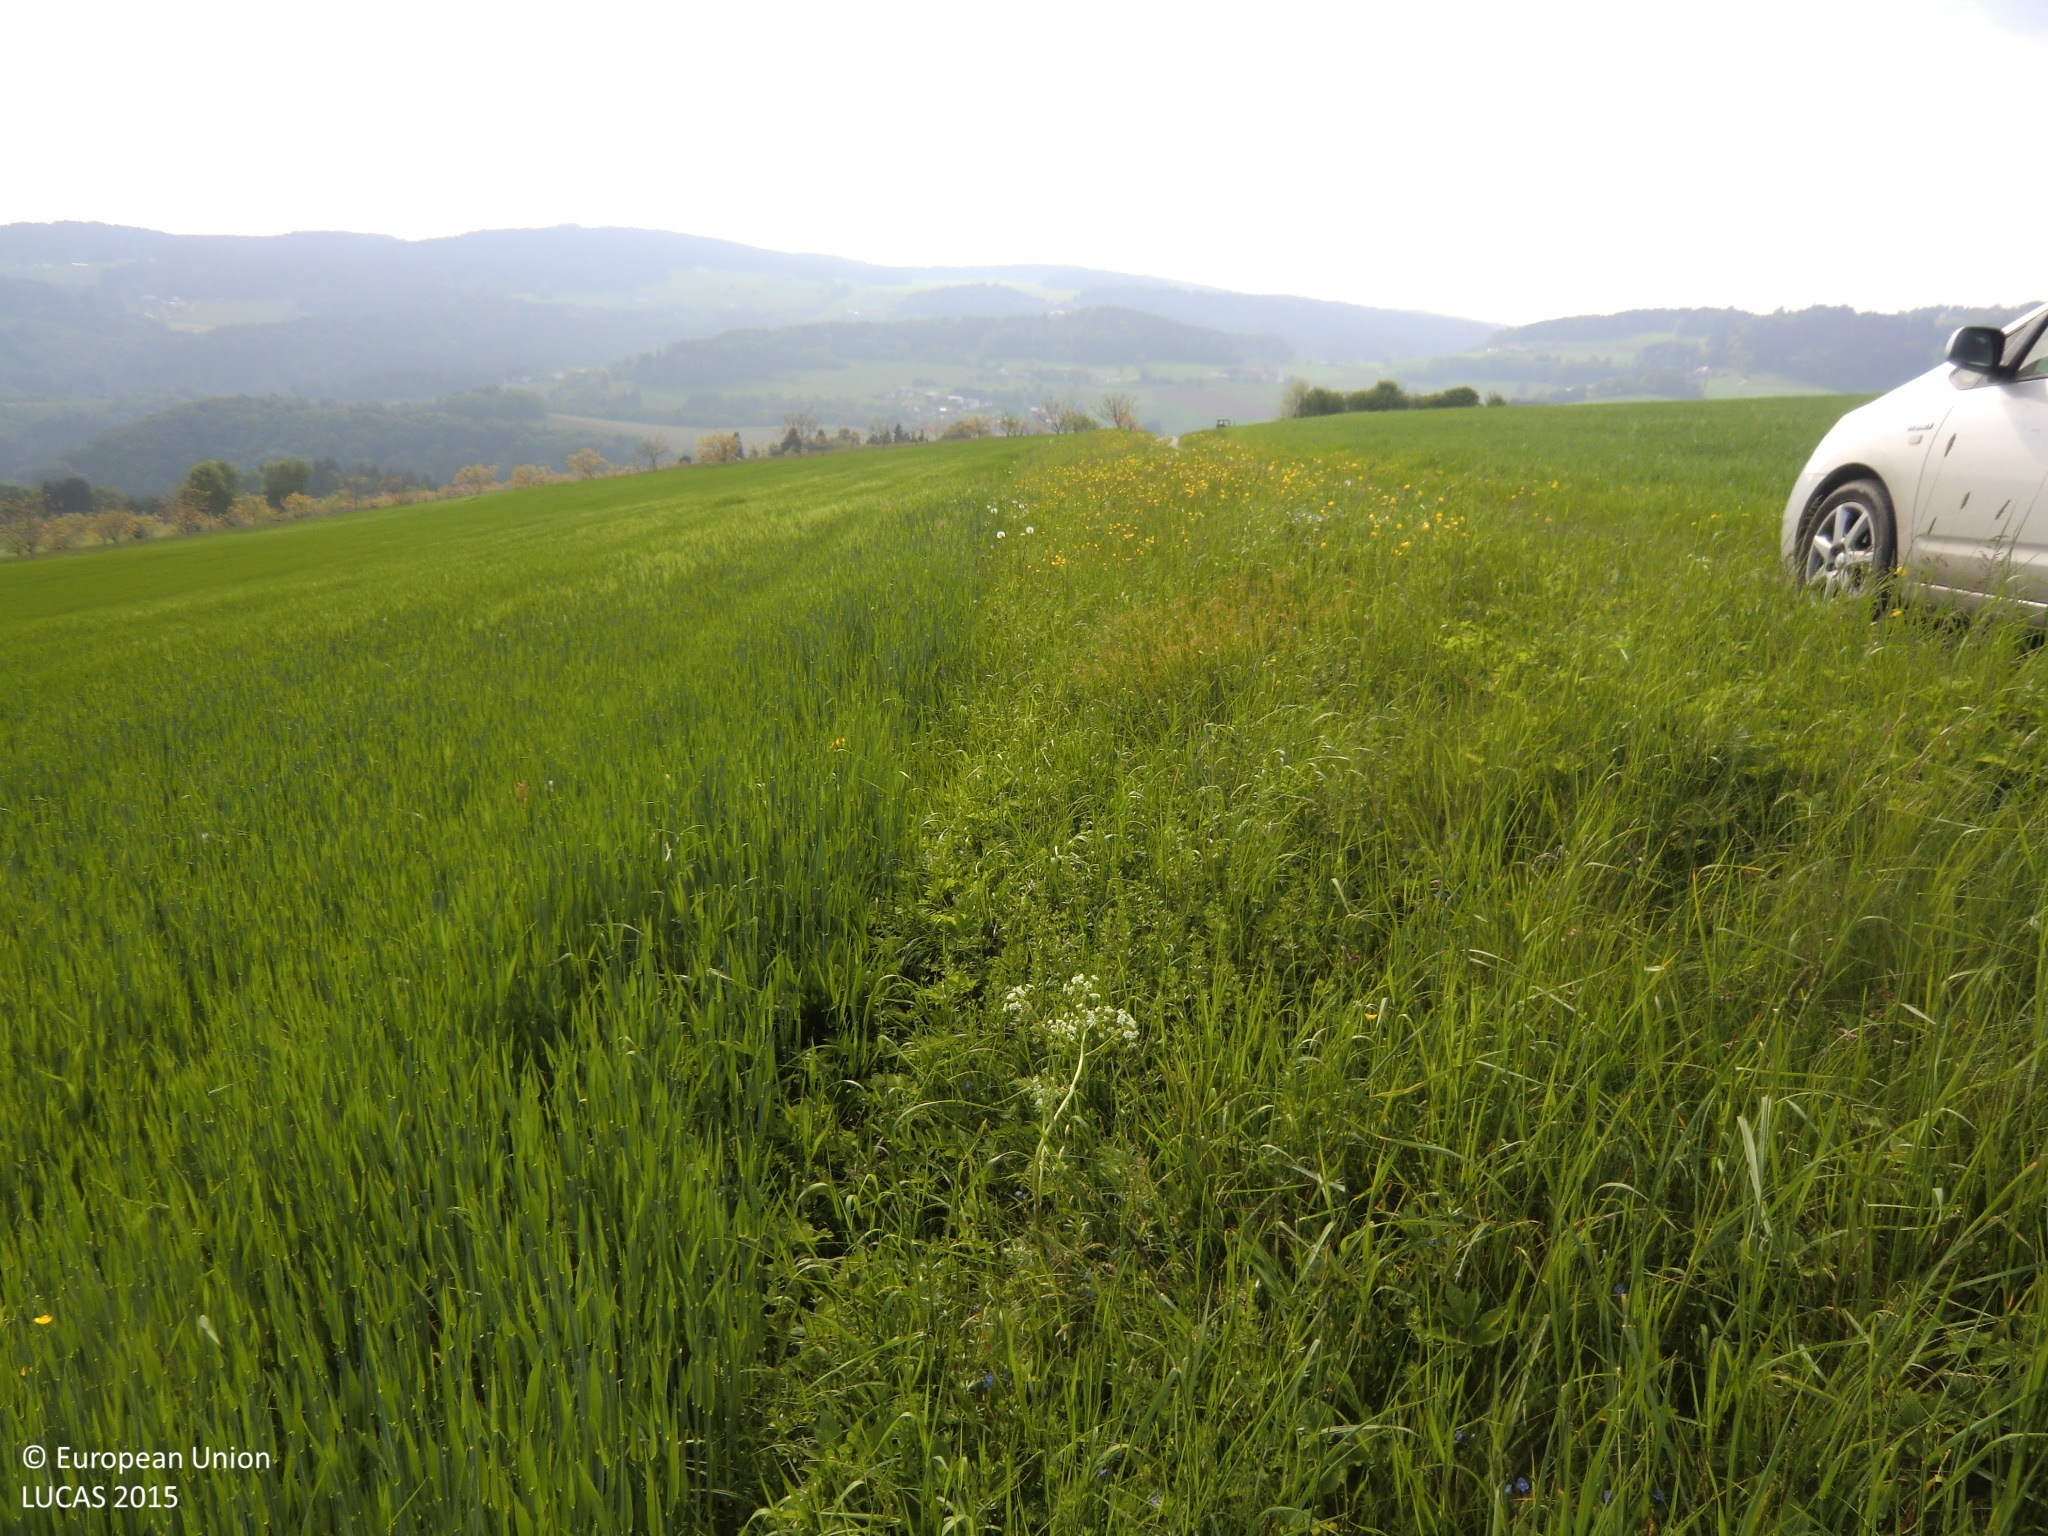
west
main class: Cropland
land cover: Barley
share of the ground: > 75 %
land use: Agriculture (excluding fallow land and kitchen gardens)
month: May
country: AT
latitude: 48.3916
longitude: 14.3084
